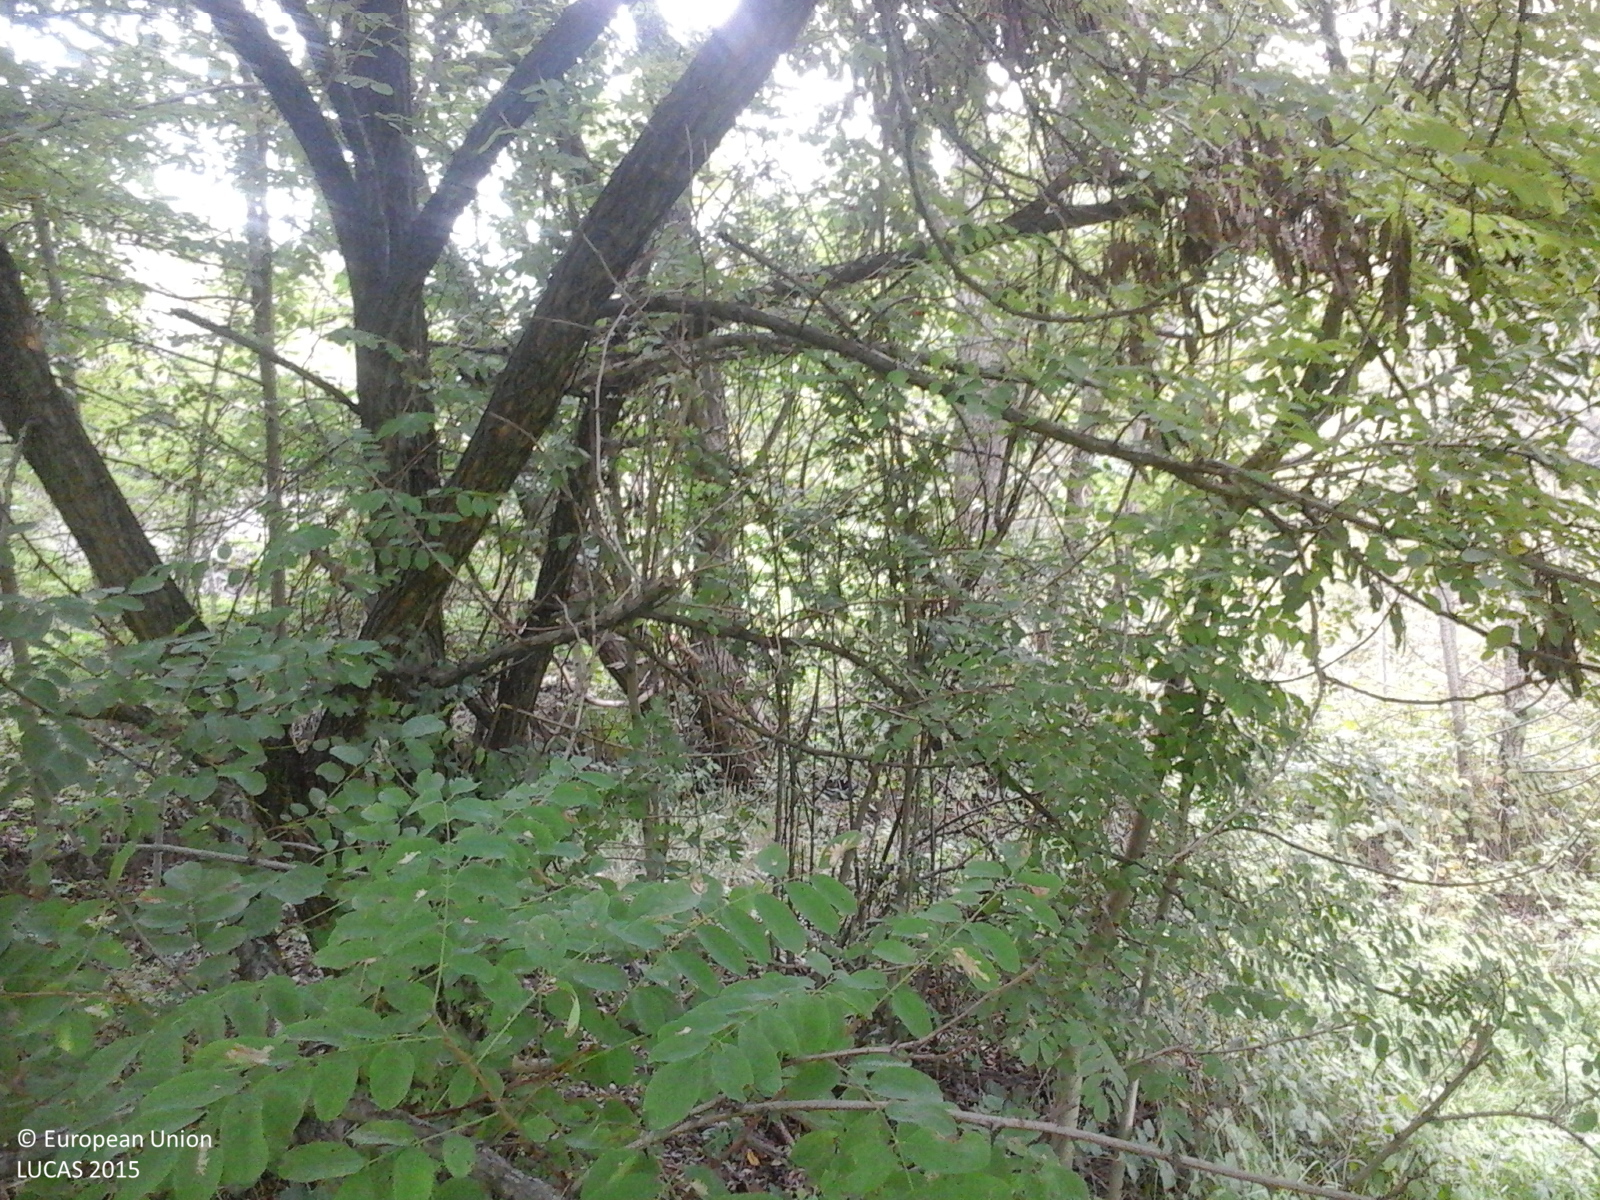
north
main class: Woodland
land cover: Broadleaved woodland
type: exotic forest
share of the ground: > 75 %
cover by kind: broadleaved forest trees 100 %
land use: Forestry
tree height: > 5 m
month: September
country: RO
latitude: 44.8844
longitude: 23.1029
